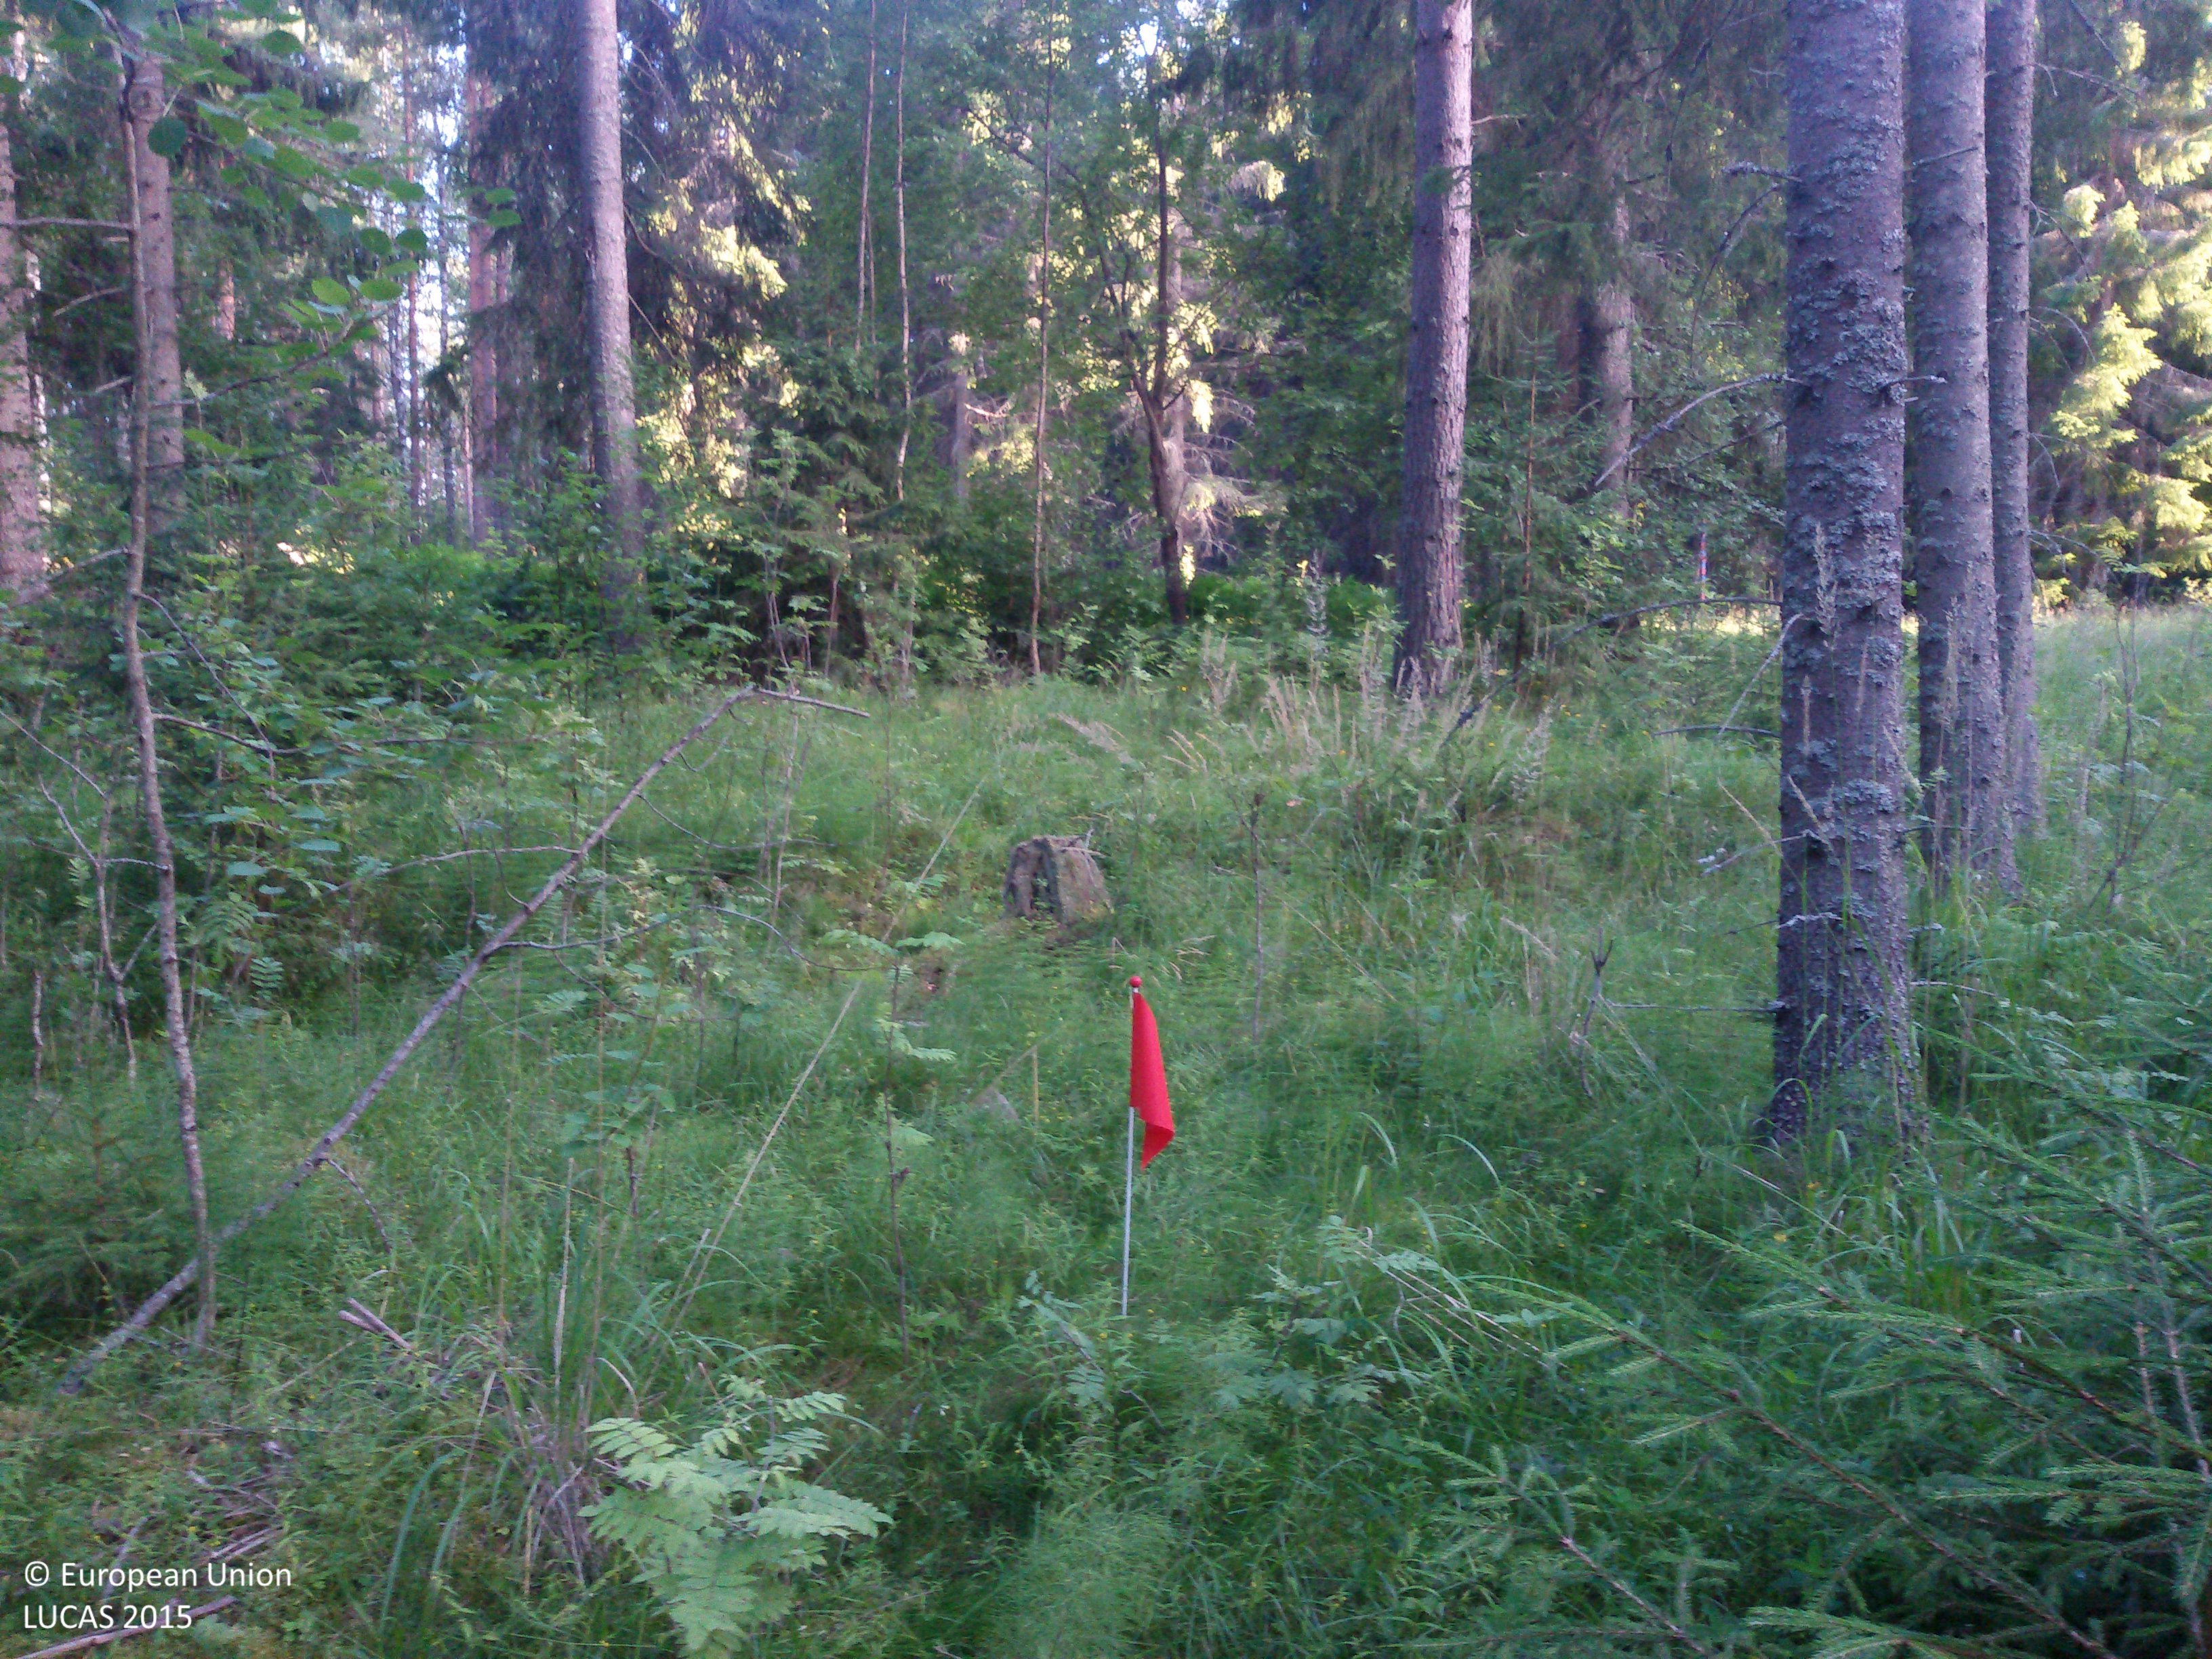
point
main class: Woodland
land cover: Spruce dominated coniferous woodland
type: boreal forest
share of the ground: 50 - 75 %
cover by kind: coniferous forest trees 60 %, herbaceous plants 20 %, broadleaved forest trees 10 %, lichens and mosses 10 %
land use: Forestry
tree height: > 5 m
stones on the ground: < 10 %
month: August
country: SE
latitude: 60.4408
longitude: 16.6219
